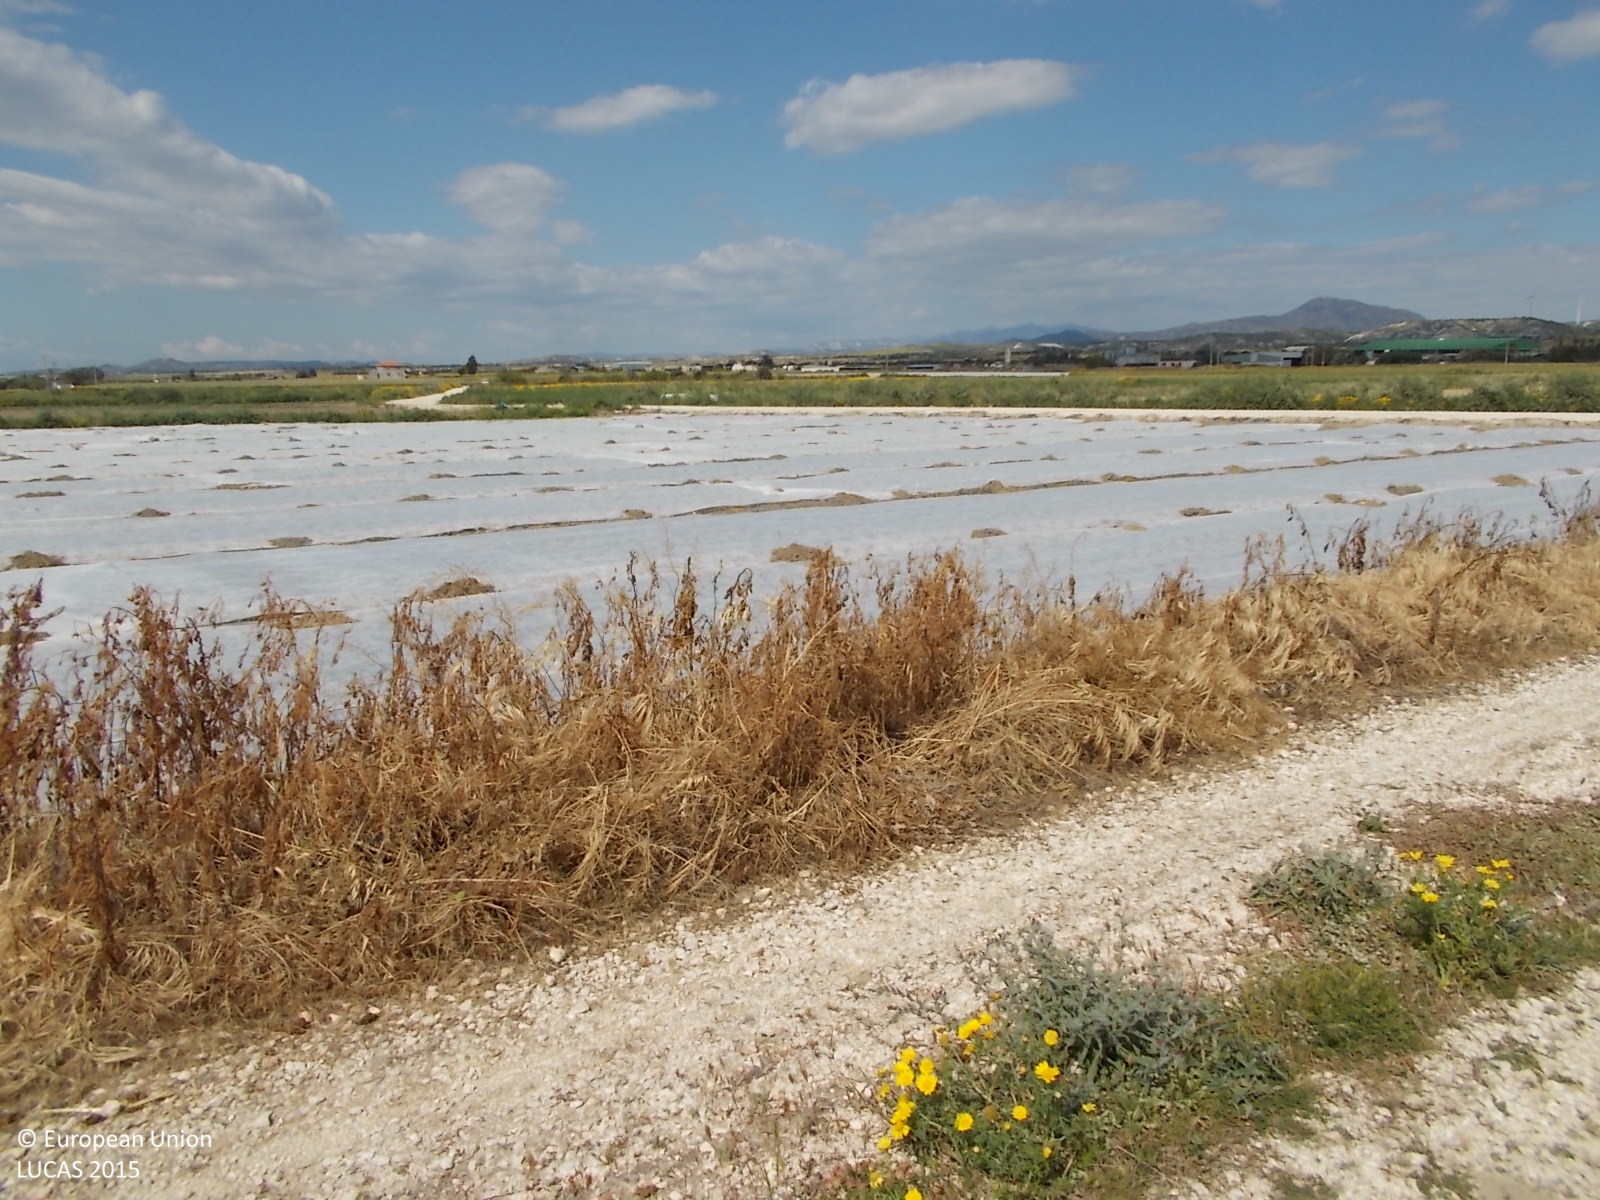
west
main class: Grassland
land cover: Grassland without tree/shrub cover
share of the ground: > 75 %
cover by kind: herbaceous plants 100 %
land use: Agriculture (excluding fallow land and kitchen gardens)
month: April
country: CY
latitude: 34.8369
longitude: 33.5590
